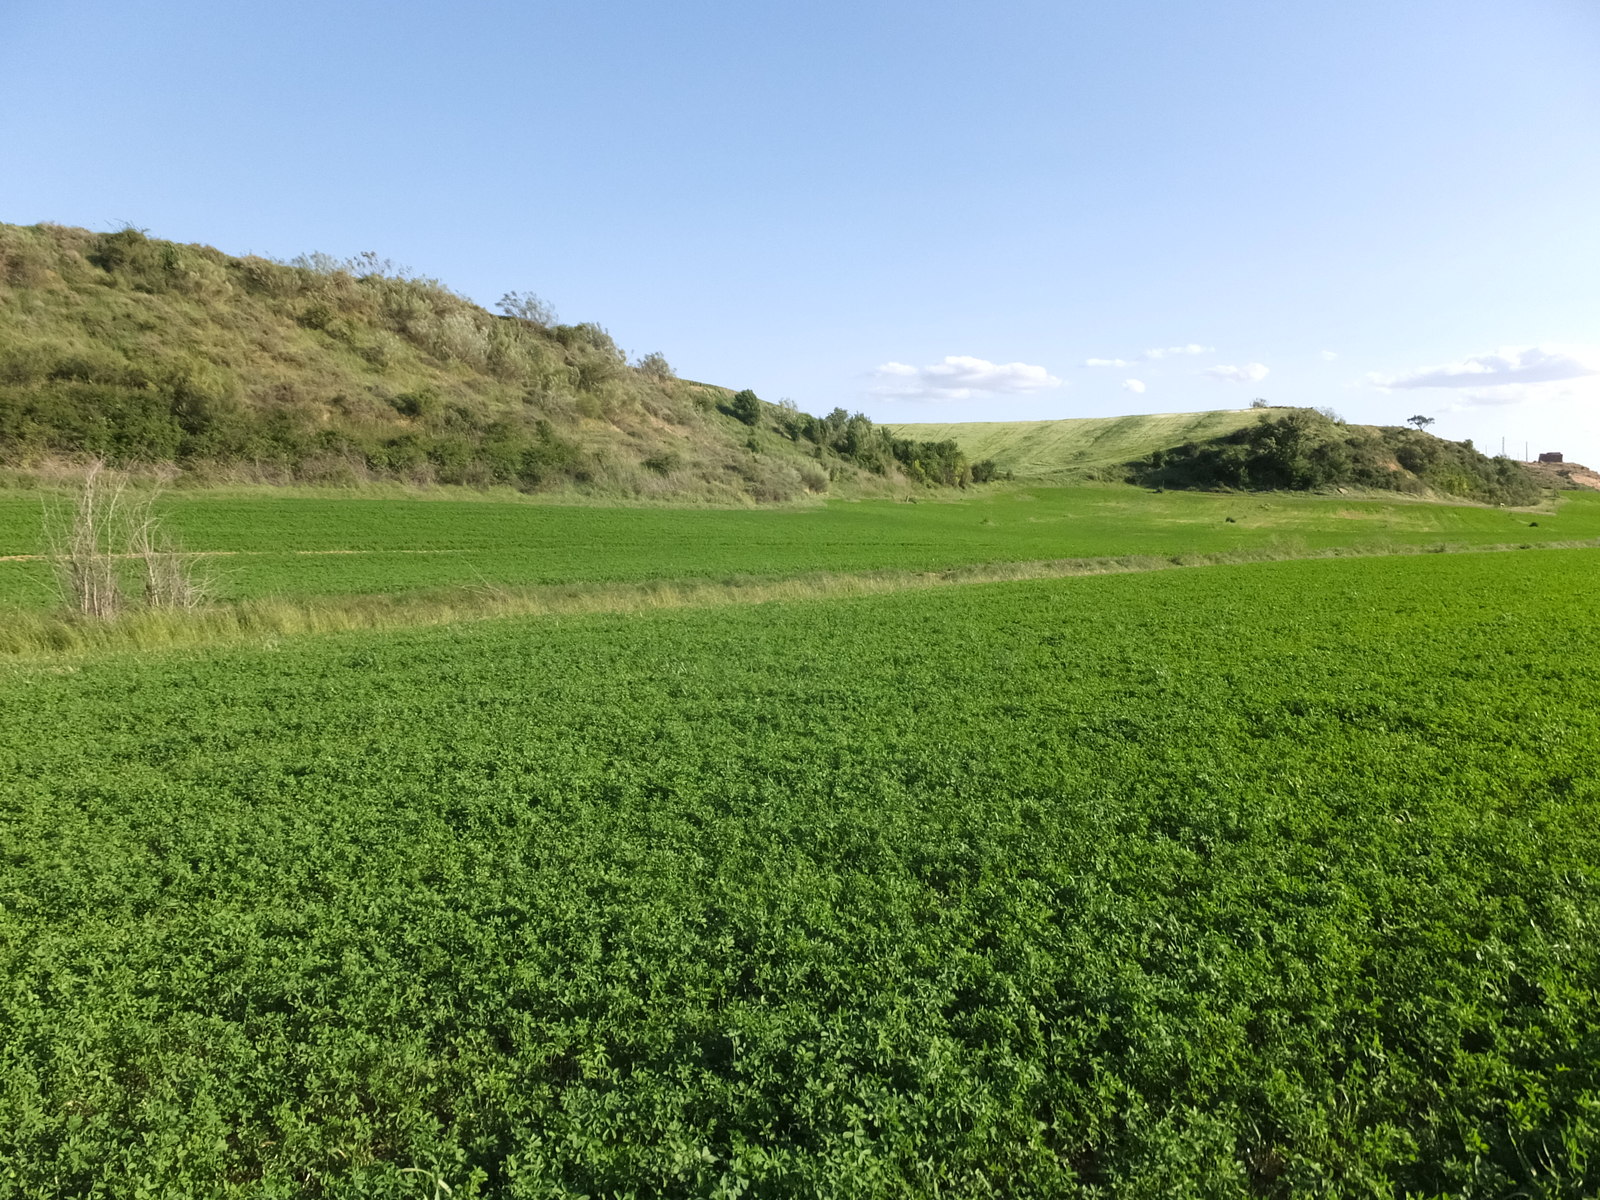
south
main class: Cropland
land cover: Lucerne
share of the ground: > 75 %
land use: Agriculture (excluding fallow land and kitchen gardens)
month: May
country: ES
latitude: 41.6353
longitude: 0.4190
